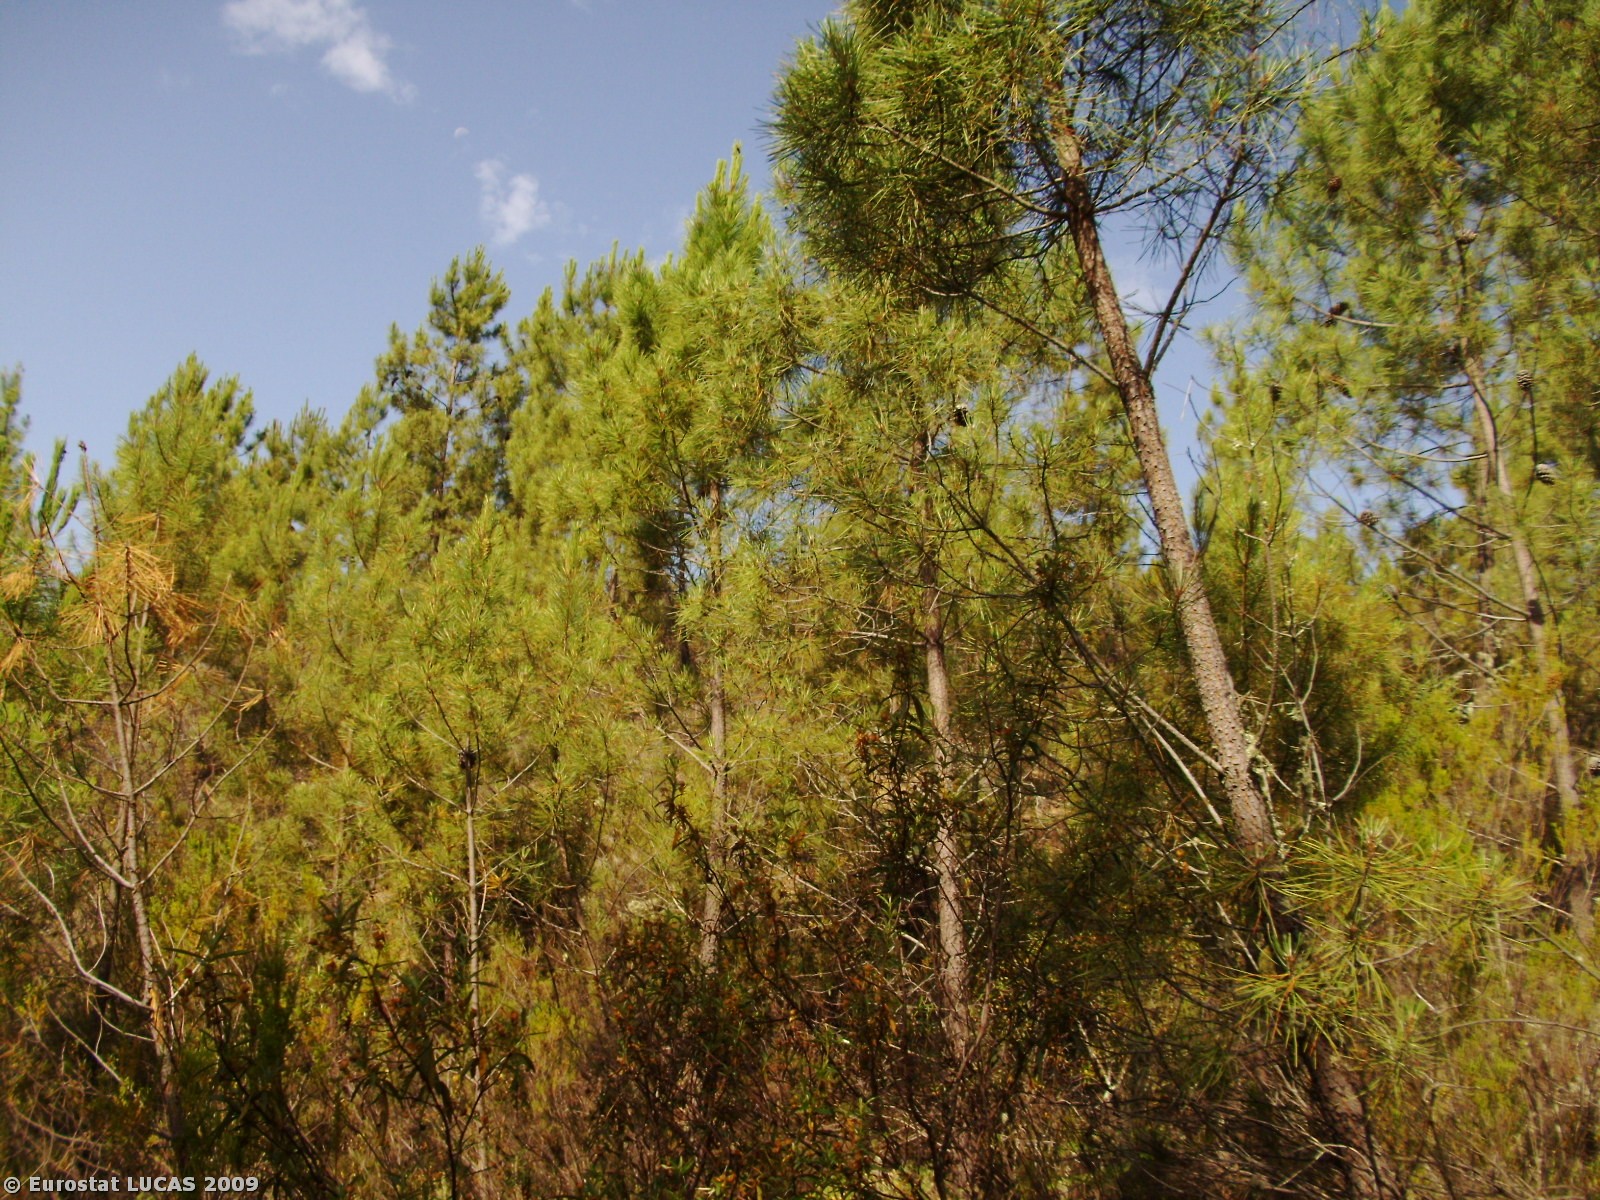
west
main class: Woodland
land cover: Coniferous woodland
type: coniferous forest of the mediterranean region
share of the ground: > 75 %
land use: Forestry
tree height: > 5 m
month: June
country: PT
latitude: 39.9672
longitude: -7.6314
